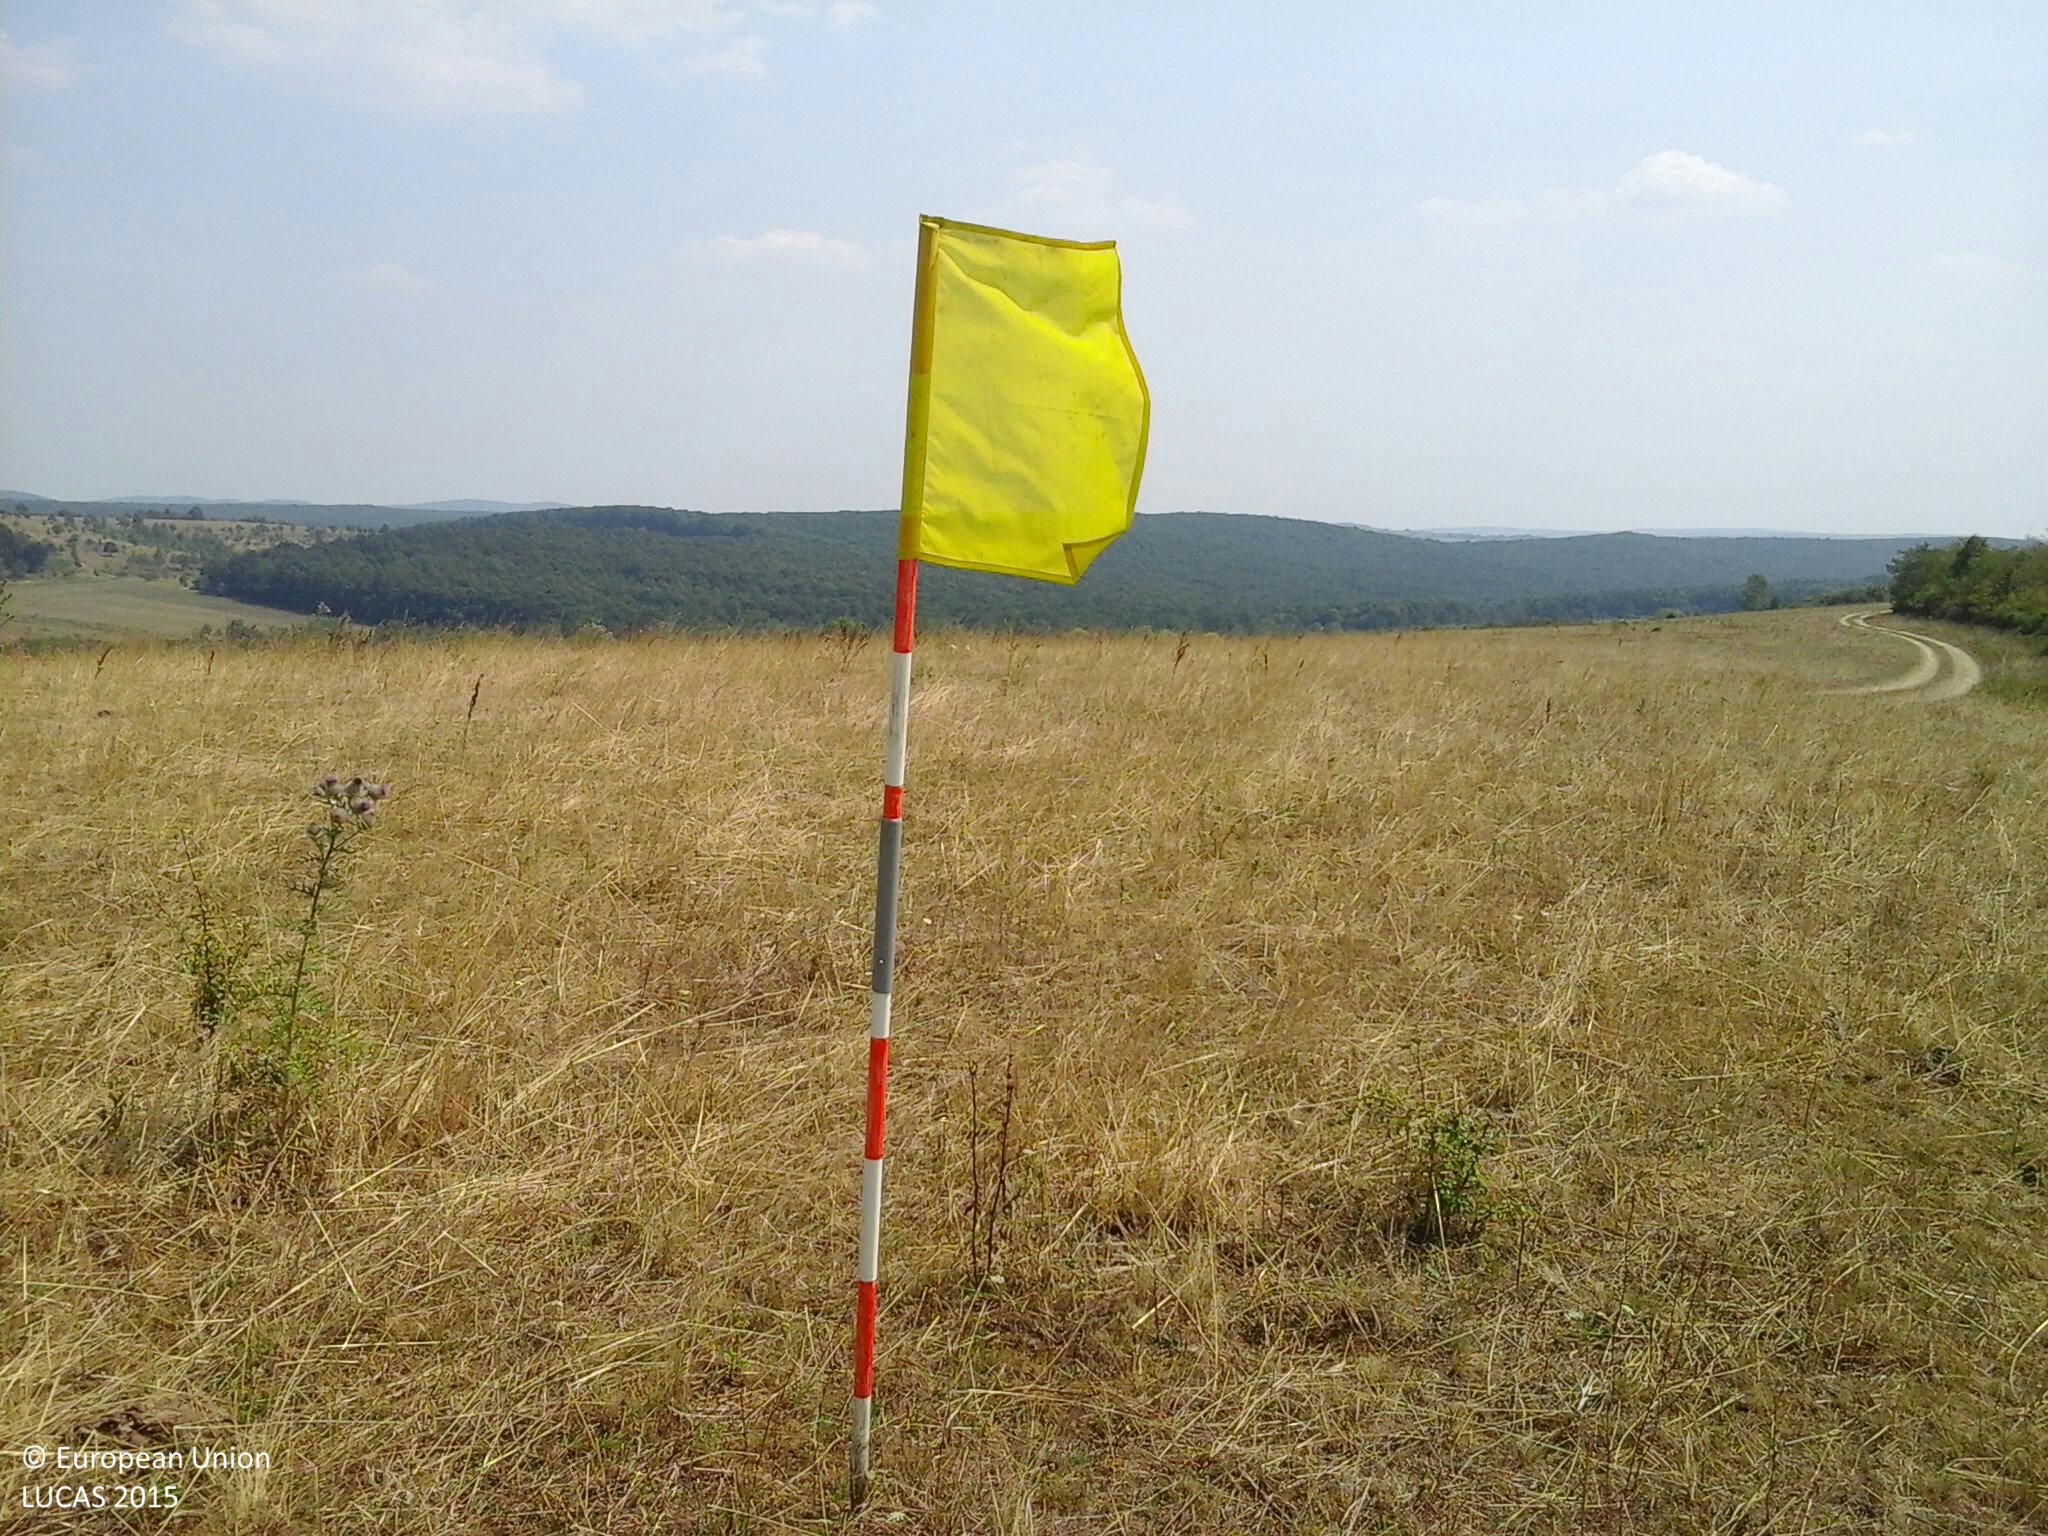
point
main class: Grassland
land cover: Grassland without tree/shrub cover
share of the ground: > 75 %
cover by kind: herbaceous plants 100 %
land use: Agriculture (excluding fallow land and kitchen gardens)
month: August
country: HU
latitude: 48.4071
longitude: 20.5314
